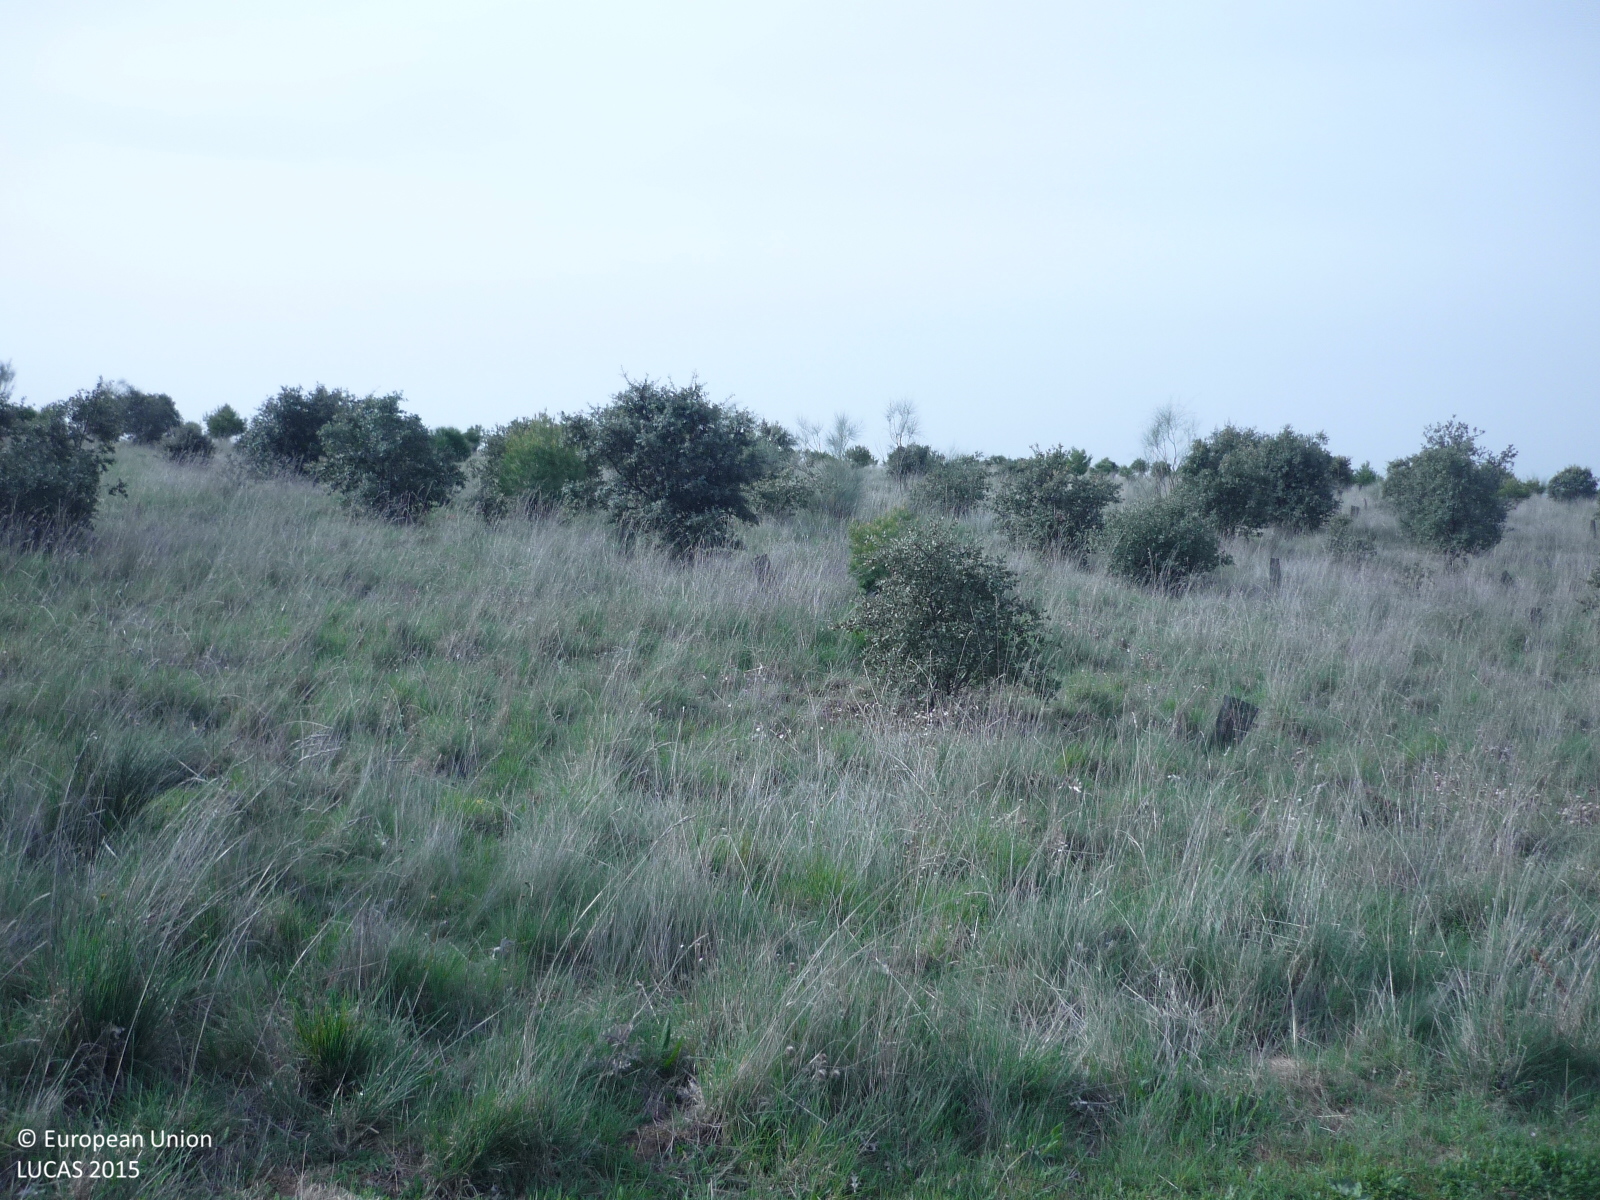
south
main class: Woodland
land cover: Broadleaved woodland
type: broadleaved evergreen forest
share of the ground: 50 - 75 %
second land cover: Grassland without tree/shrub cover
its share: > 75 %
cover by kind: broadleaved forest trees 60 %, herbaceous plants 25 %, unconsolidated bare surface 10 %, shrubs 5 %
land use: Forestry
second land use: Agriculture (excluding fallow land and kitchen gardens)
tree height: < 5 m
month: April
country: ES
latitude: 40.6597
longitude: -3.4142
